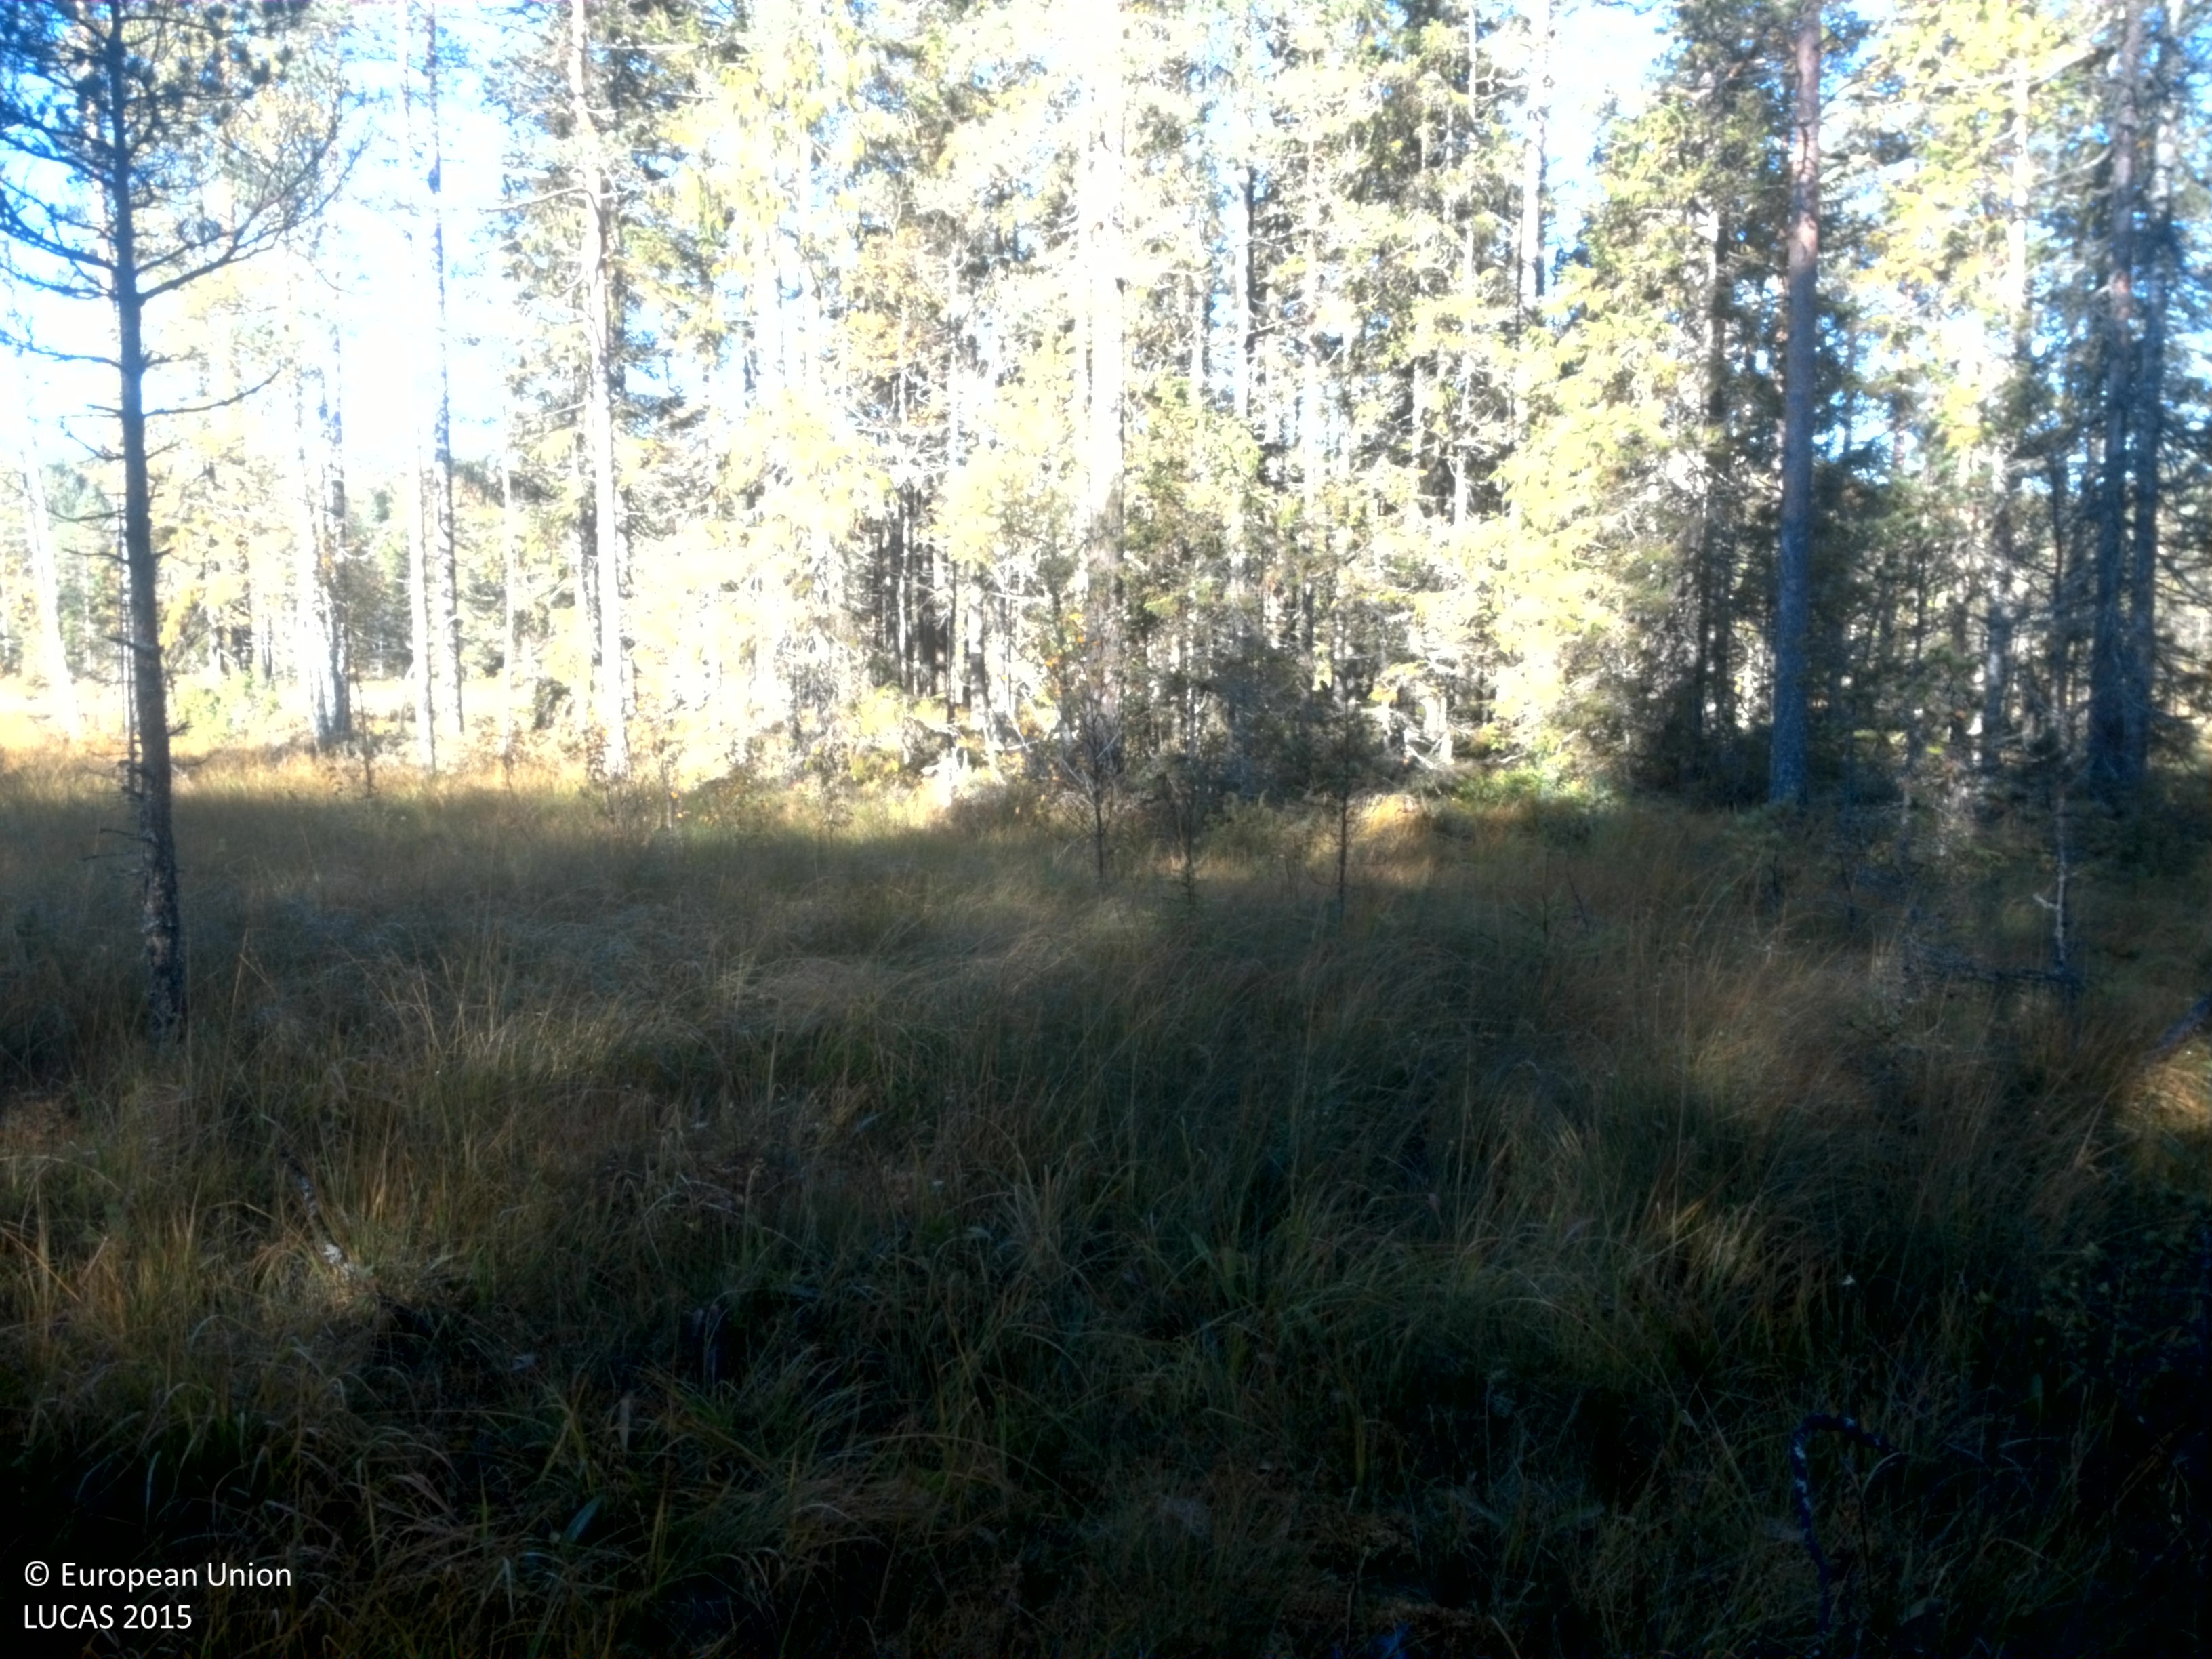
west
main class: Woodland
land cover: Other mixed woodland
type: mire and swamp forests
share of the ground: 50 - 75 %
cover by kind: coniferous forest trees 45 %, broadleaved forest trees 15 %, herbaceous plants 15 %, lichens and mosses 15 %, shrubs 10 %
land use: Forestry
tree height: > 5 m
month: September
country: SE
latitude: 59.9047
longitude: 15.1924
